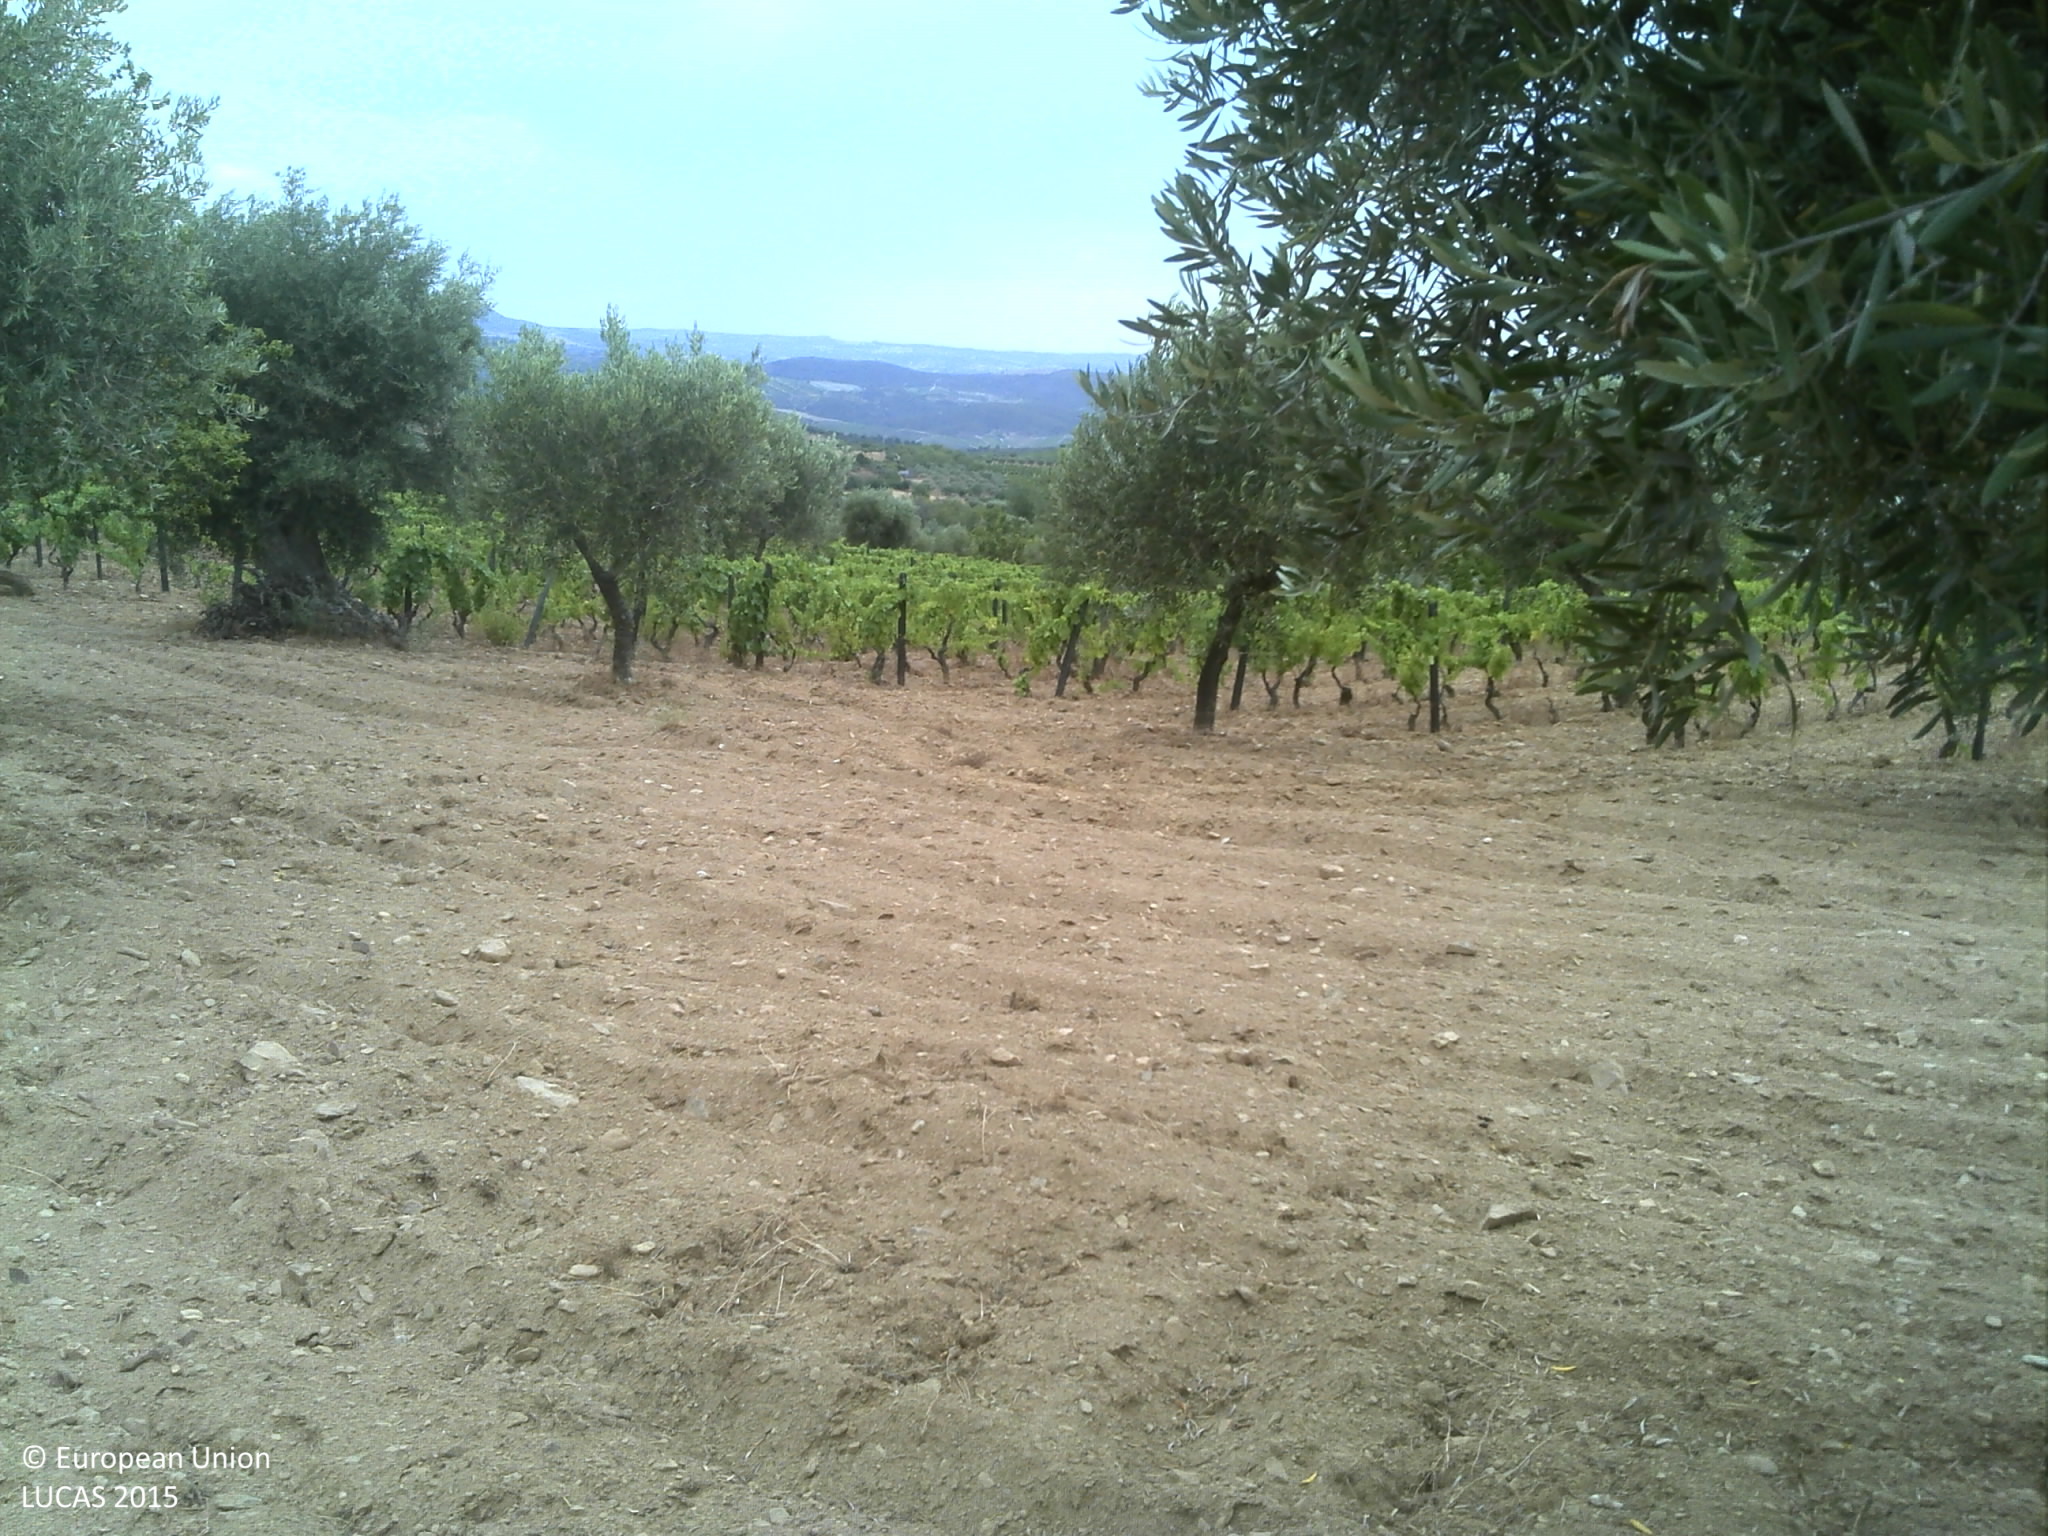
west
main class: Cropland
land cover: Olive groves
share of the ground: < 10 %
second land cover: Other bare soil
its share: > 75 %
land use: Agriculture (excluding fallow land and kitchen gardens)
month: July
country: PT
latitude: 41.0488
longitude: -7.2579
